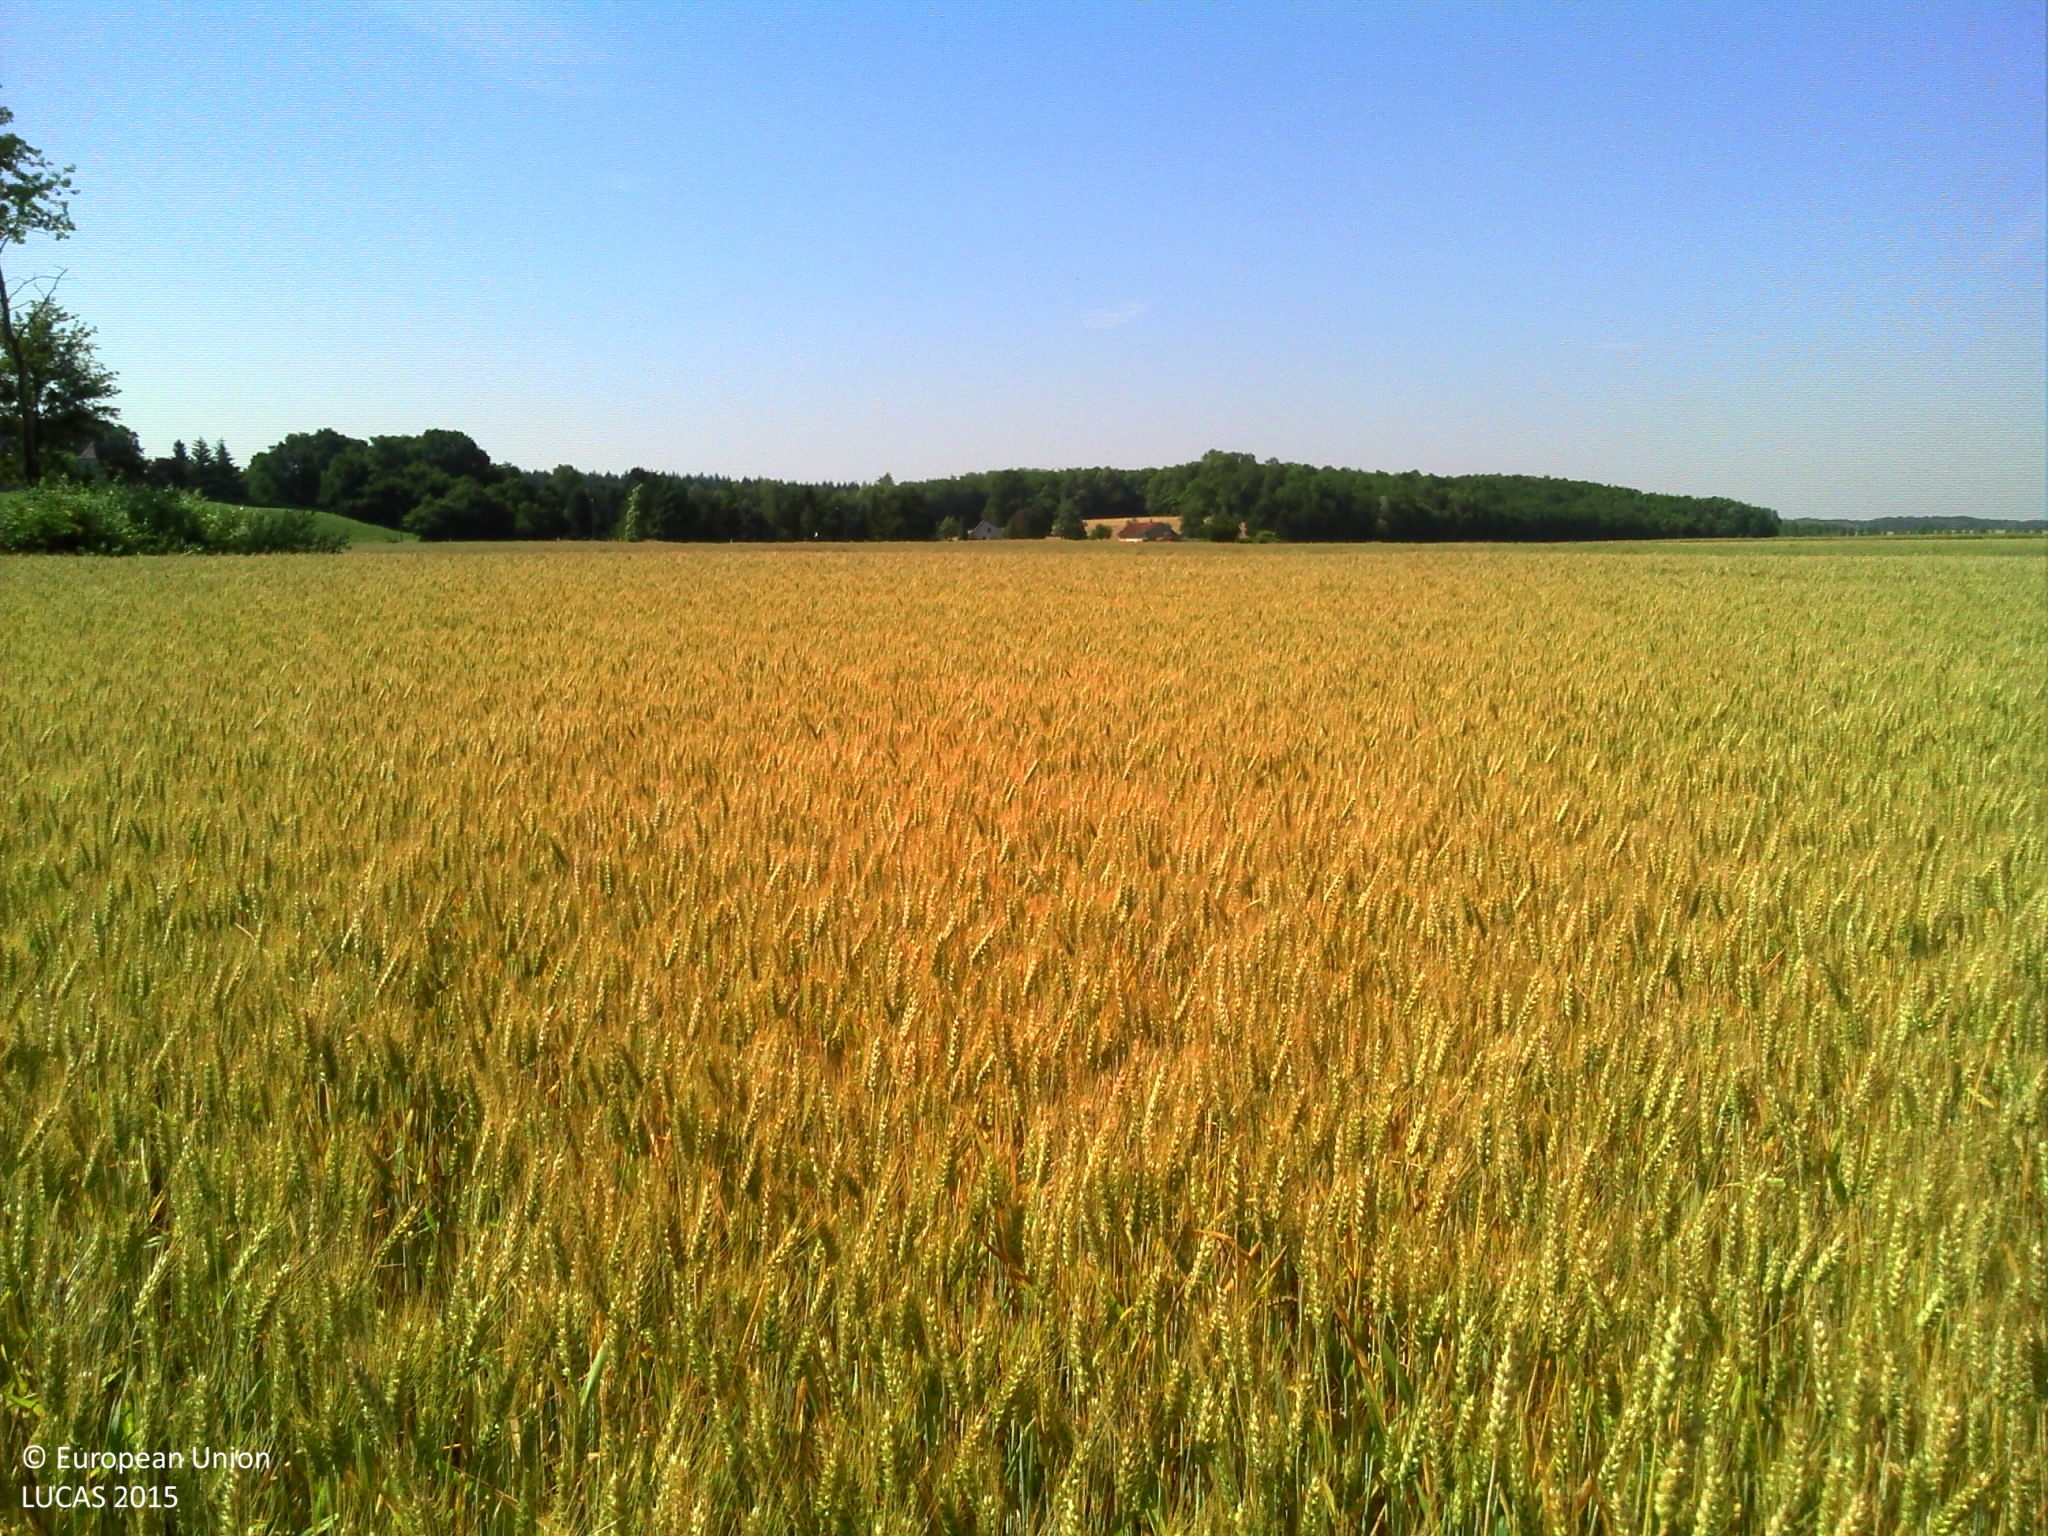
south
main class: Cropland
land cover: Common wheat
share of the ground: > 75 %
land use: Agriculture (excluding fallow land and kitchen gardens)
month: June
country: FR
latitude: 46.9160
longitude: 5.3140
